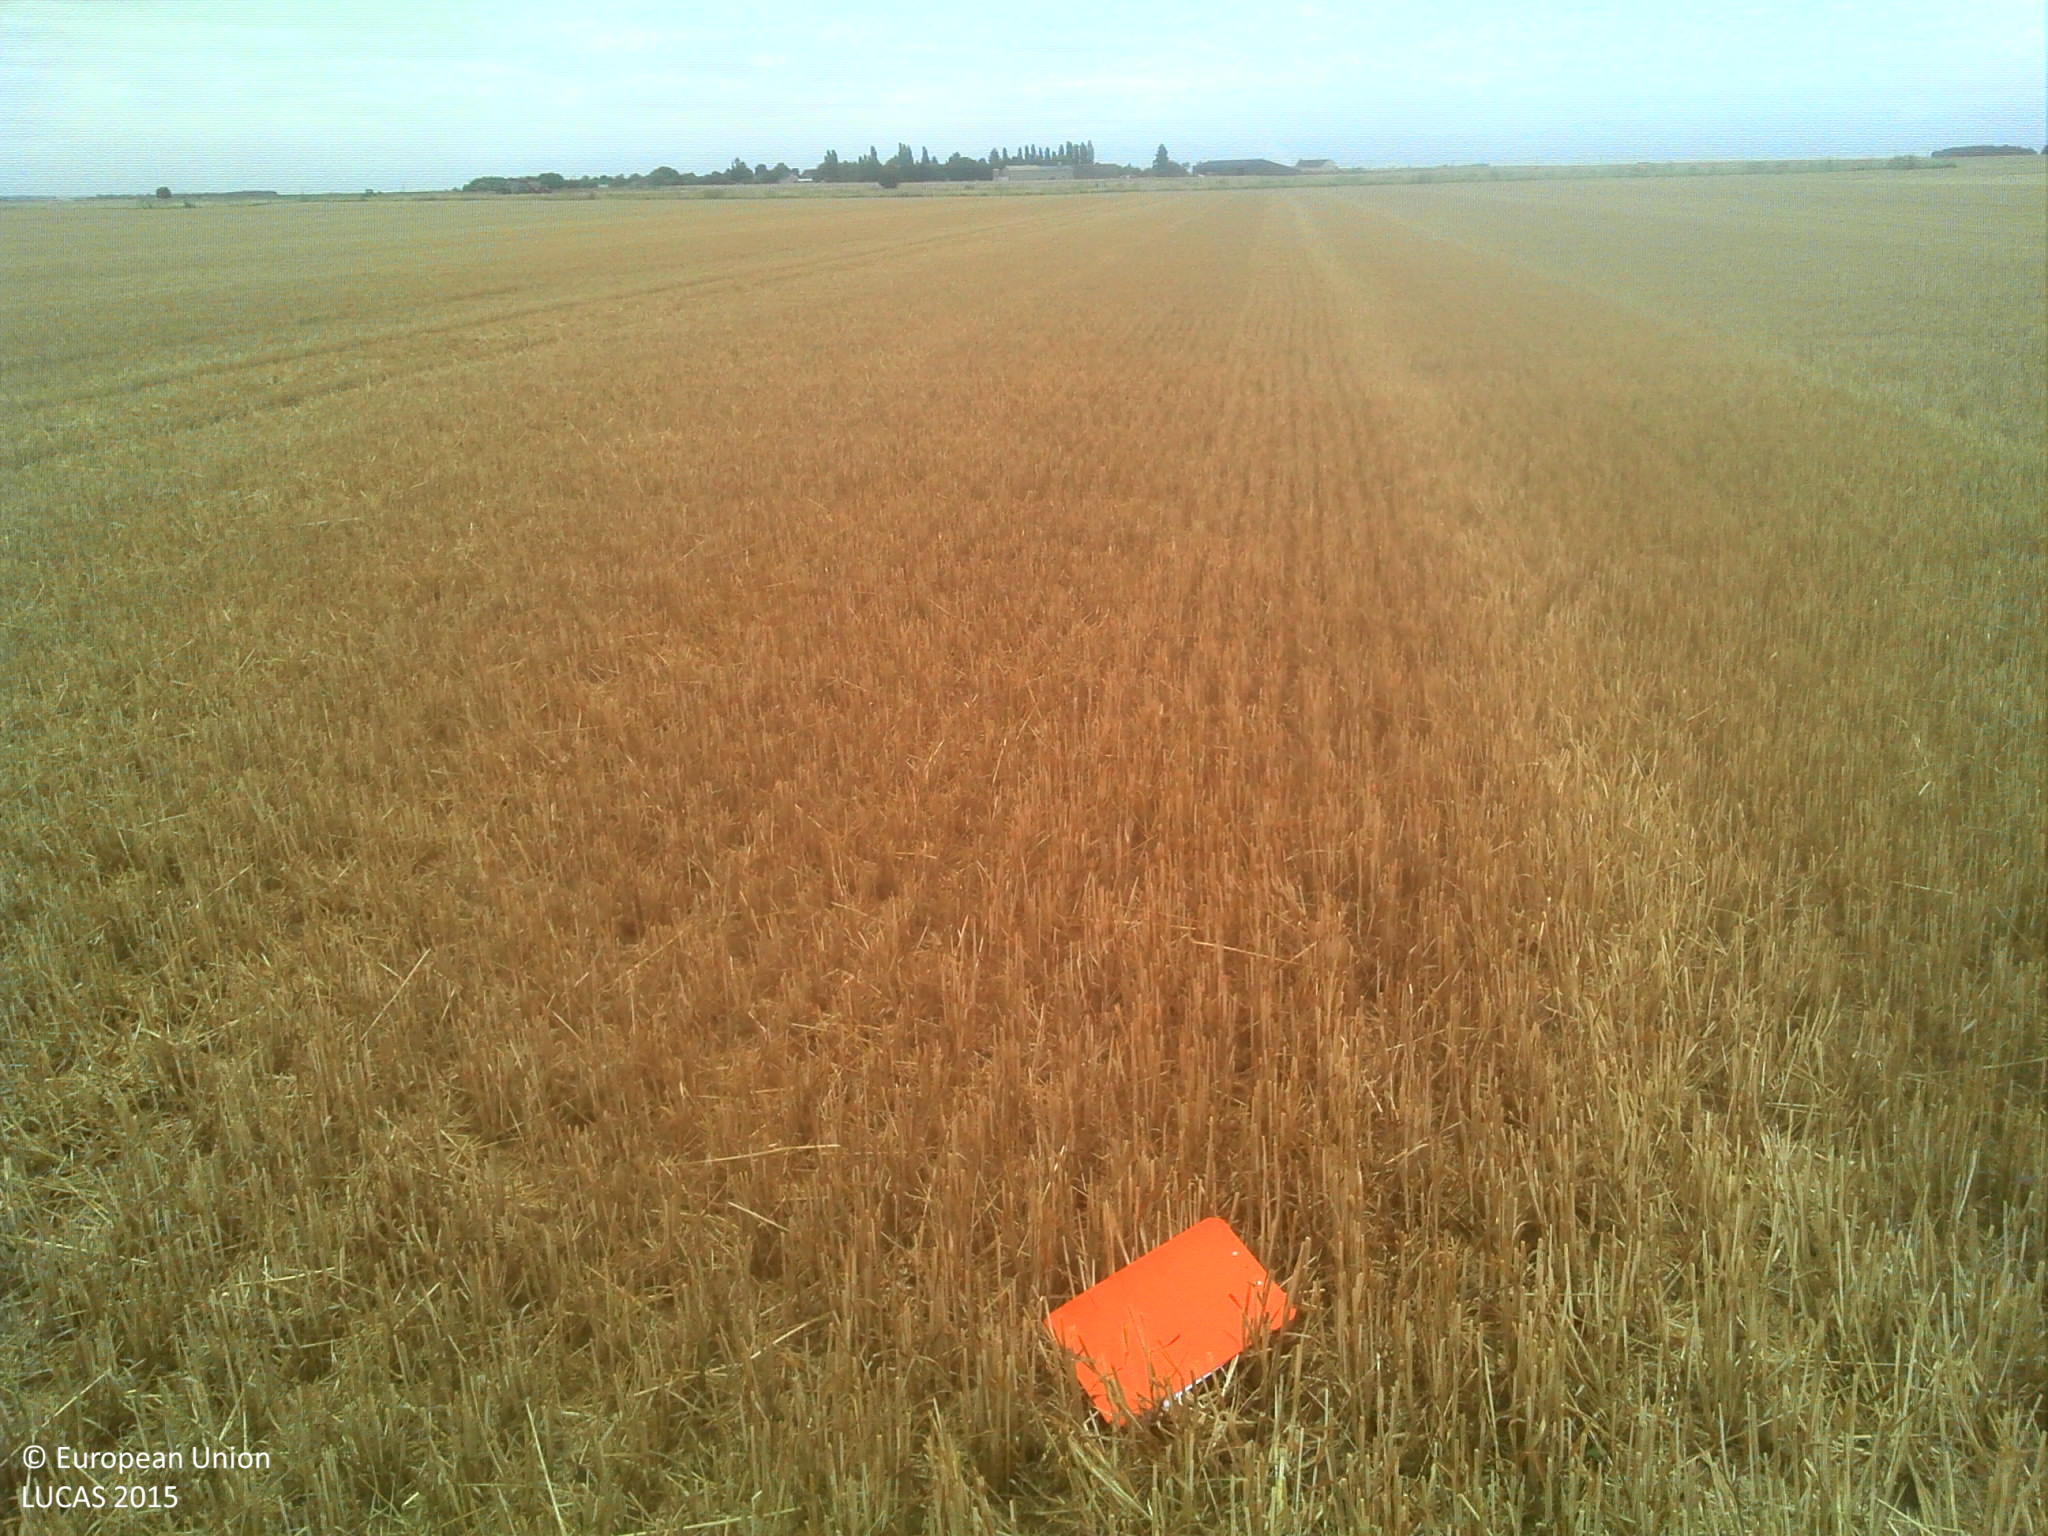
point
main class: Cropland
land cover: Durum wheat
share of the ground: > 75 %
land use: Agriculture (excluding fallow land and kitchen gardens)
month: July
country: FR
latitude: 47.7881
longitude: 1.2941
